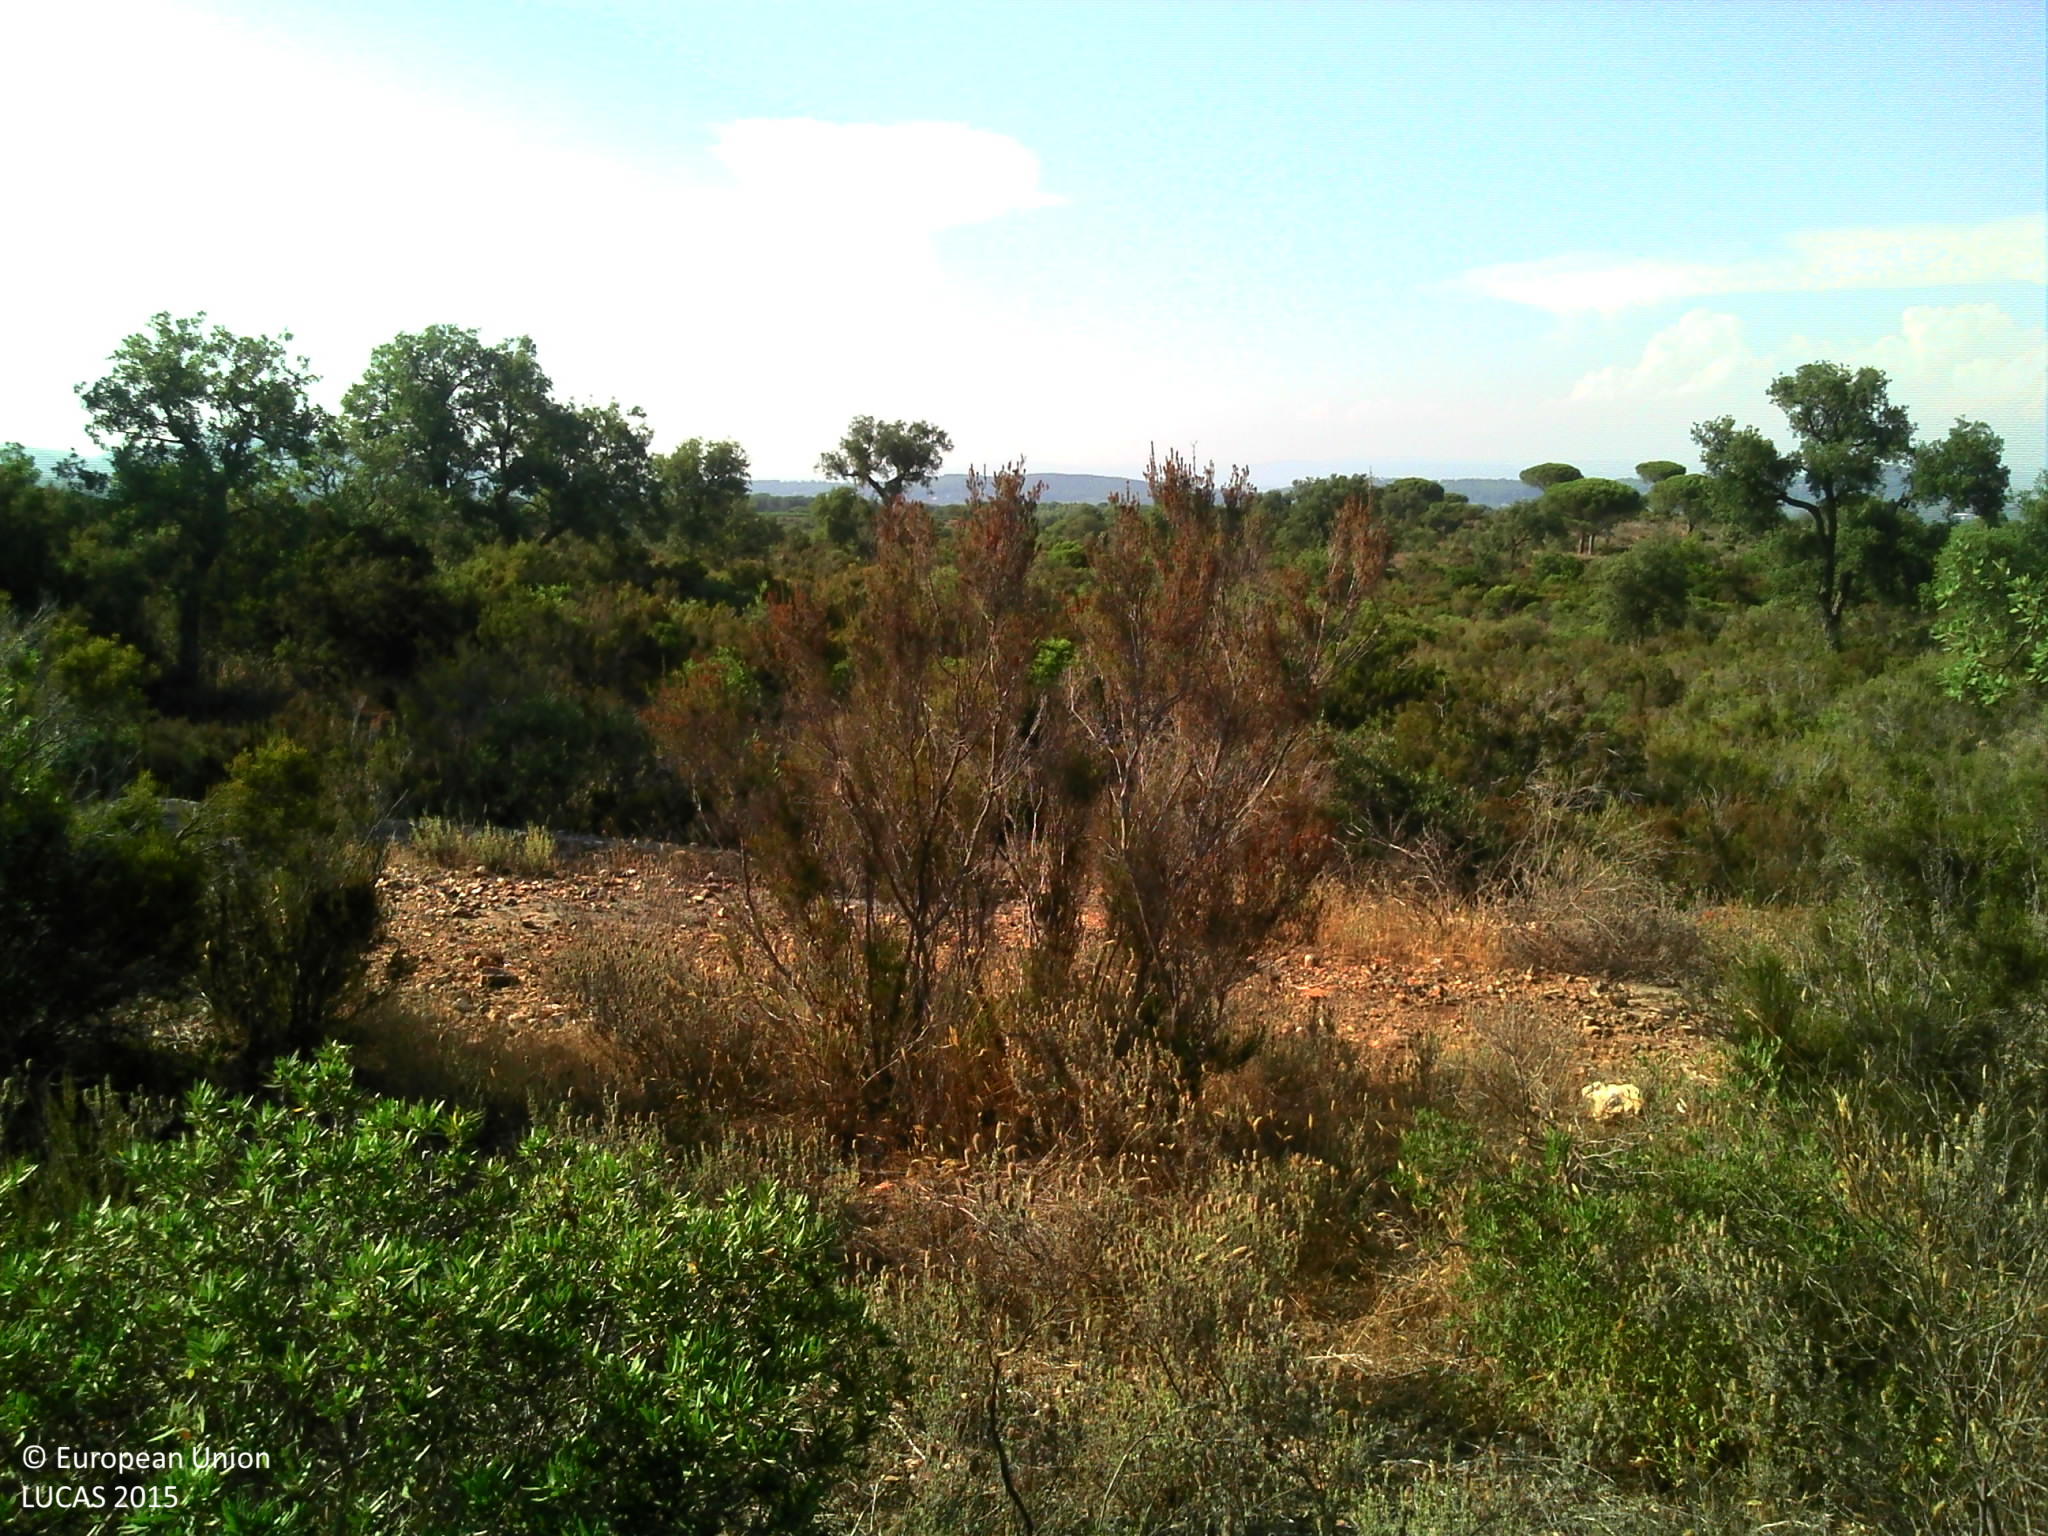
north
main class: Shrubland
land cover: Shrubland with sparse tree cover
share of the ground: > 75 %
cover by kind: shrubs 95 %, broadleaved forest trees 5 %
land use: Semi-natural and natural areas not in use
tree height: > 5 m
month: July
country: FR
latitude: 43.3488
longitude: 6.3943
